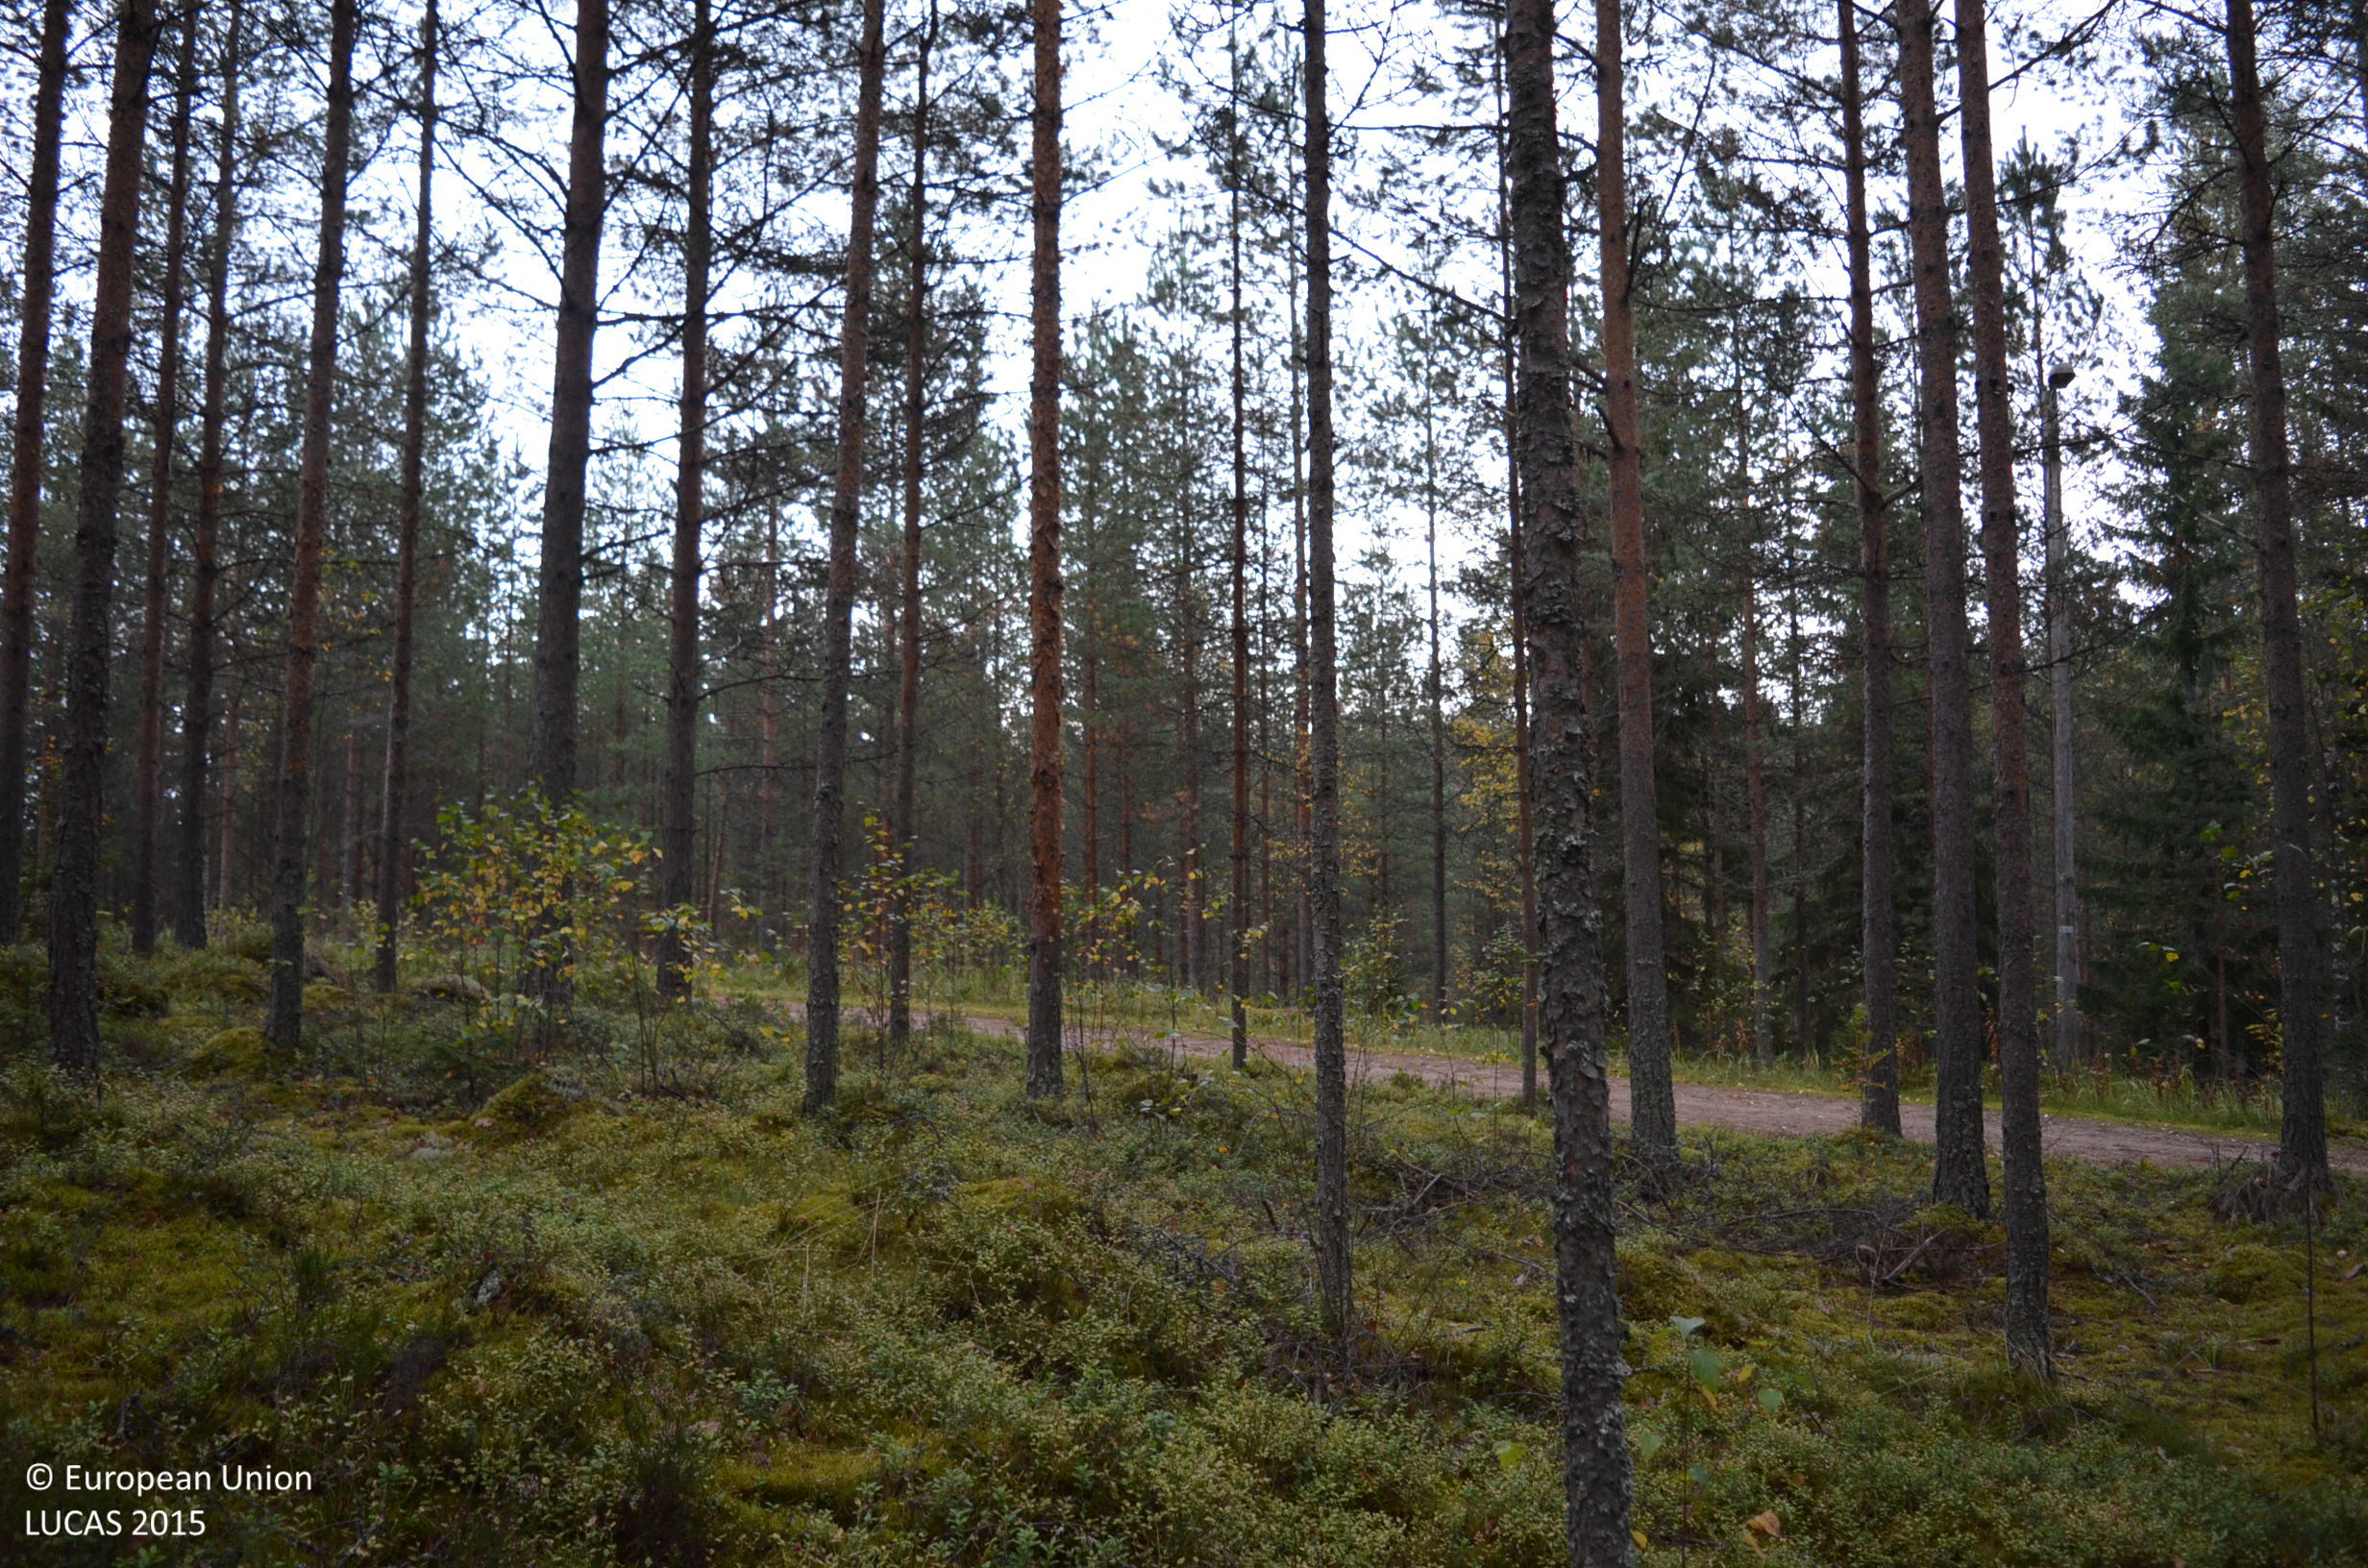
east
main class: Woodland
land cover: Pine dominated coniferous woodland
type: boreal forest
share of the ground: 50 - 75 %
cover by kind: coniferous forest trees 65 %, shrubs 25 %, broadleaved forest trees 5 %, lichens and mosses 5 %
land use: Forestry
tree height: > 5 m
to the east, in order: Pine dominated coniferous woodland; Tracks; Shruby margins; Electric lines; Pine dominated coniferous woodland; Pine dominated mixed woodland; Ditches and canals; Pine dominated mixed woodland; Other coniferous woodland
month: September
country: FI
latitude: 62.5894
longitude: 23.6836
